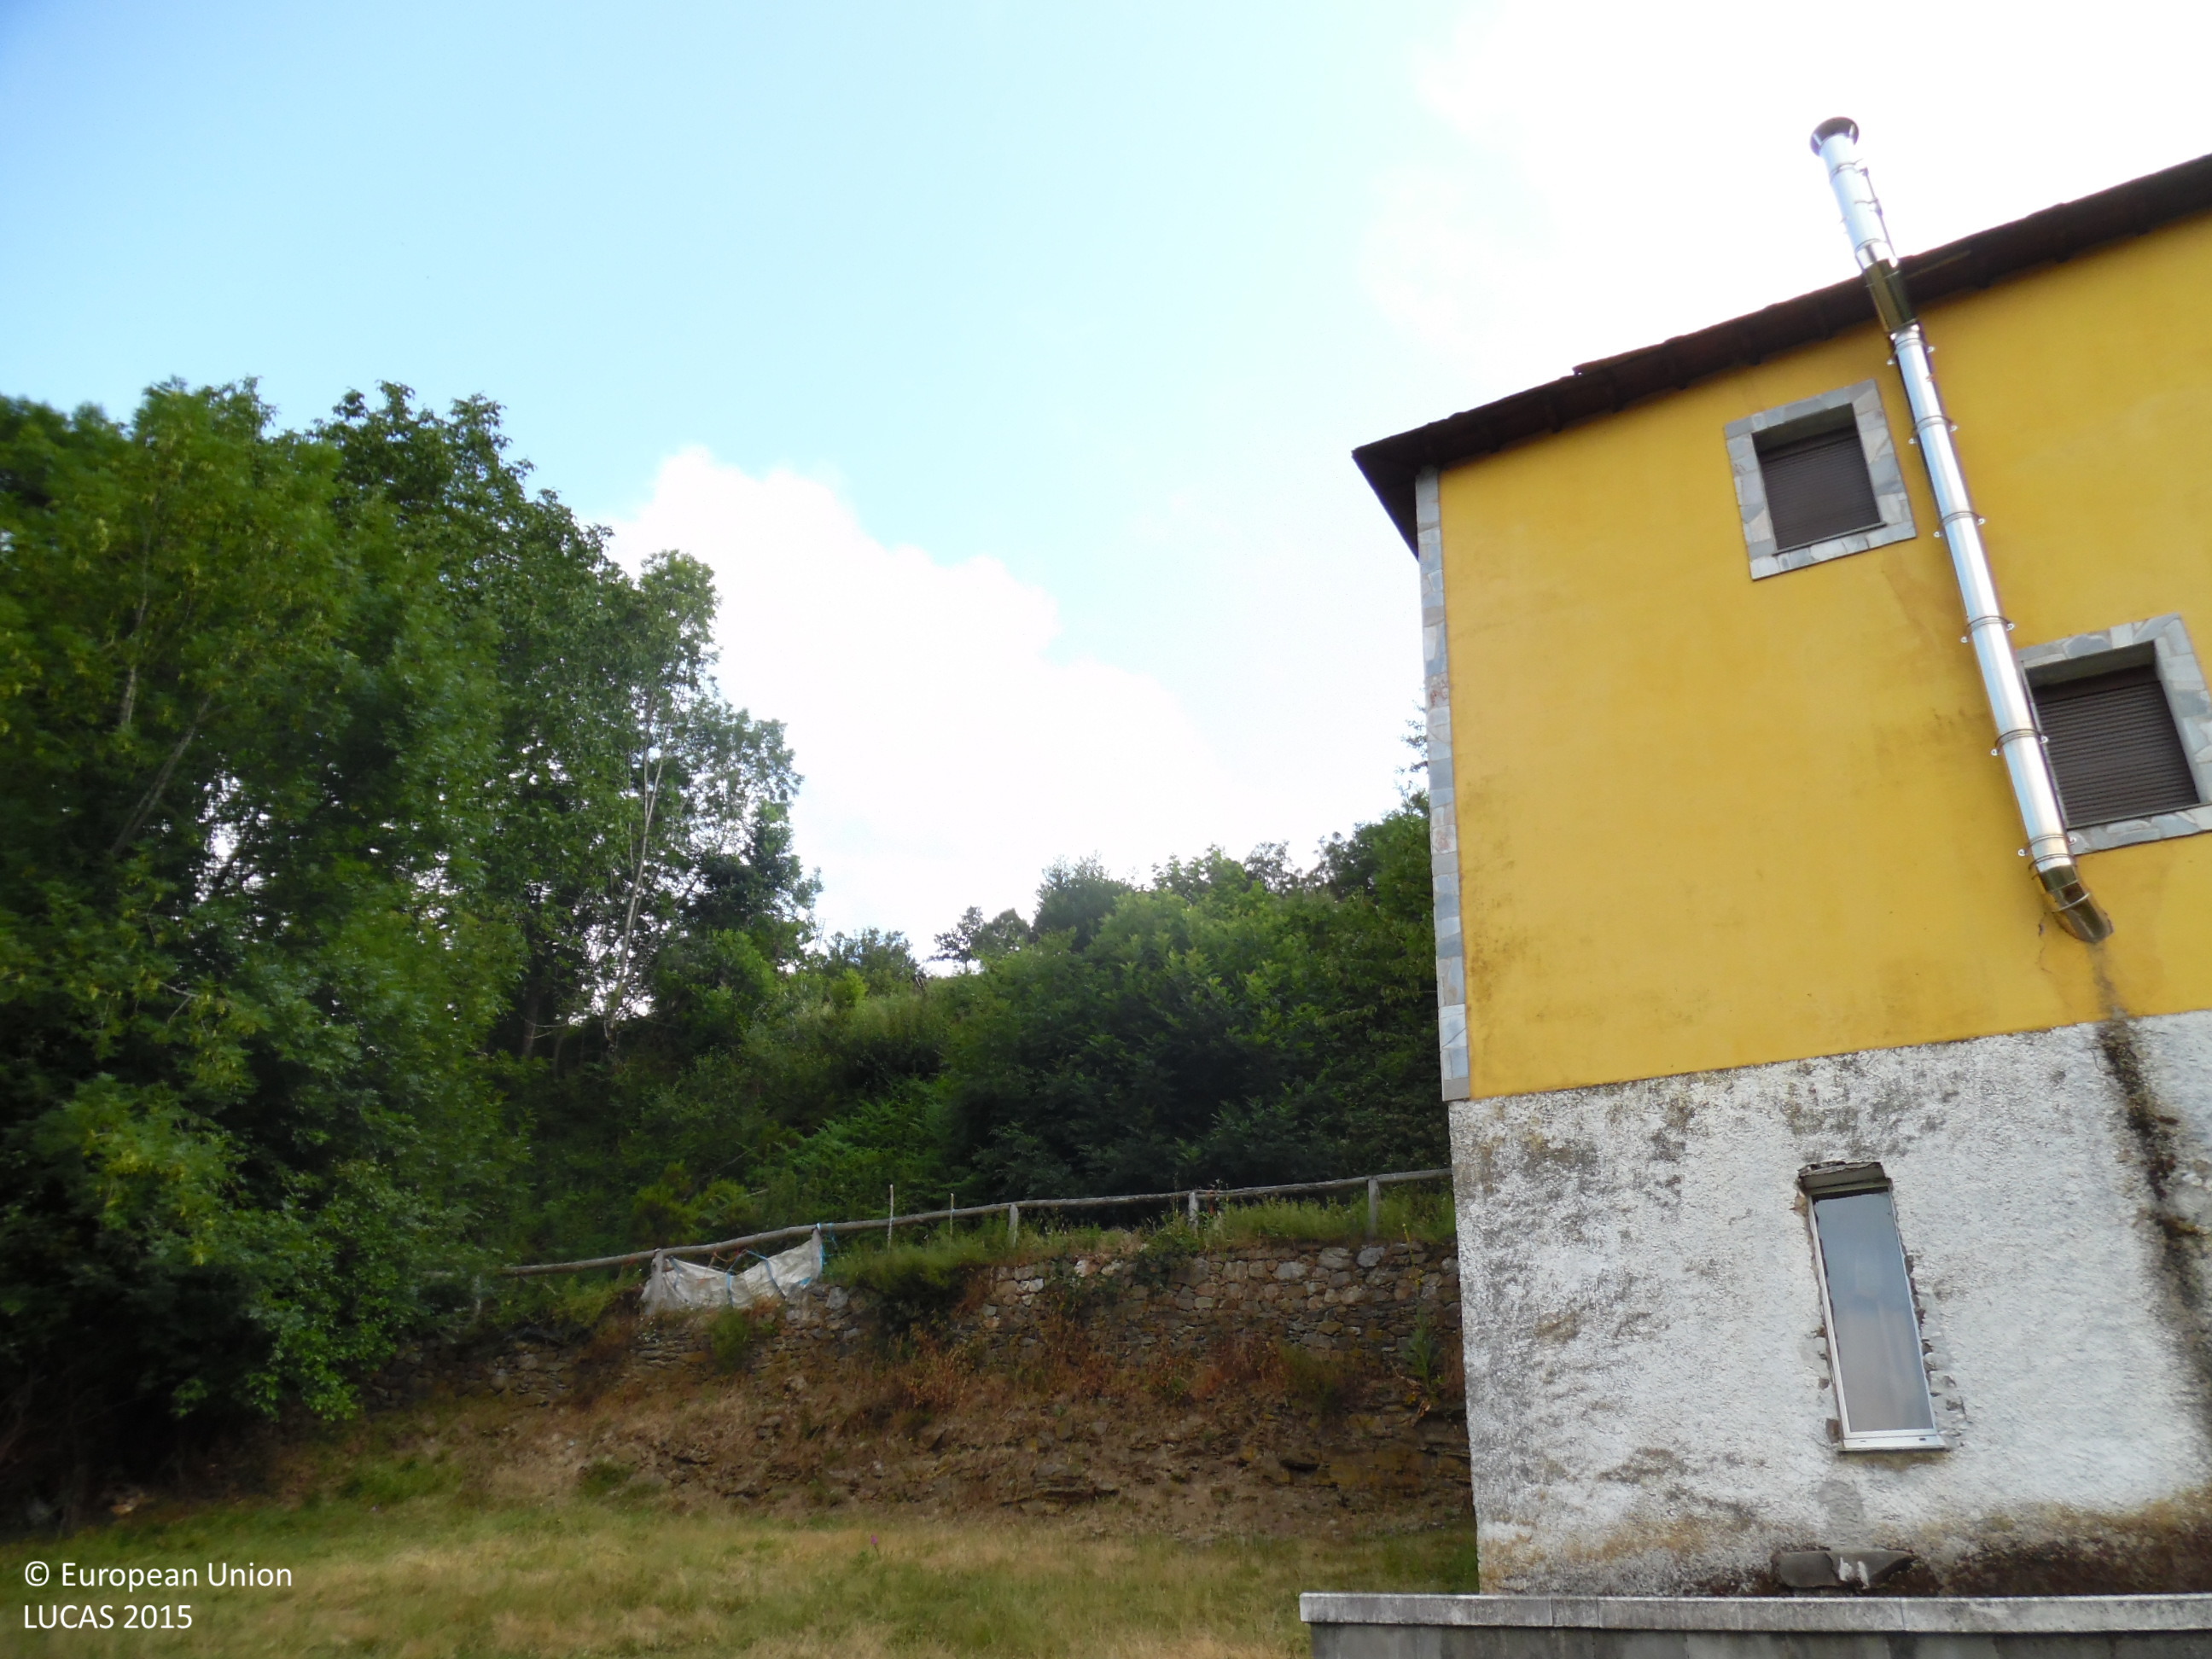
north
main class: Grassland
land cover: Grassland with sparse tree/shrub cover
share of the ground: > 75 %
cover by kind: herbaceous plants 90 %, broadleaved forest trees 5 %
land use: Agriculture (excluding fallow land and kitchen gardens)
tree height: > 5 m
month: July
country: ES
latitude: 43.0451
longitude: -6.5624
